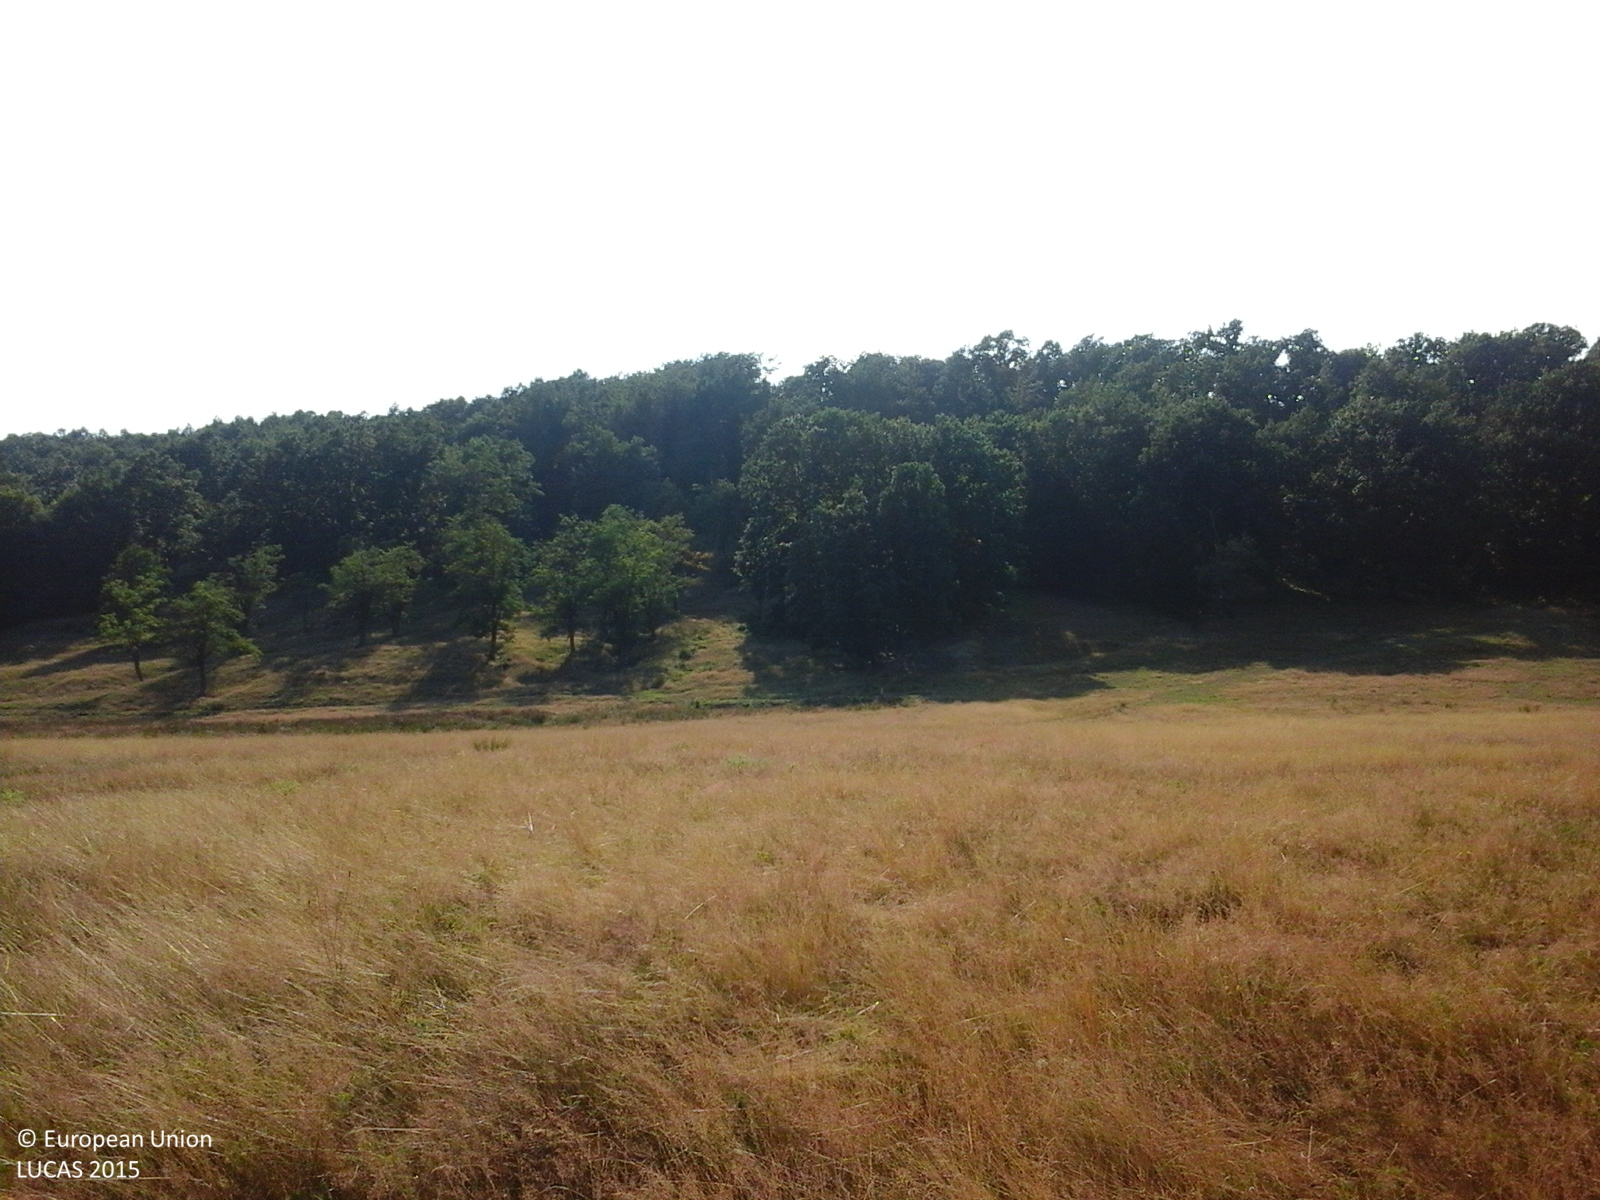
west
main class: Grassland
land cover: Grassland without tree/shrub cover
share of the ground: > 75 %
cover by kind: herbaceous plants 100 %
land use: Agriculture (excluding fallow land and kitchen gardens)
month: July
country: RO
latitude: 44.9349
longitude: 24.5079
